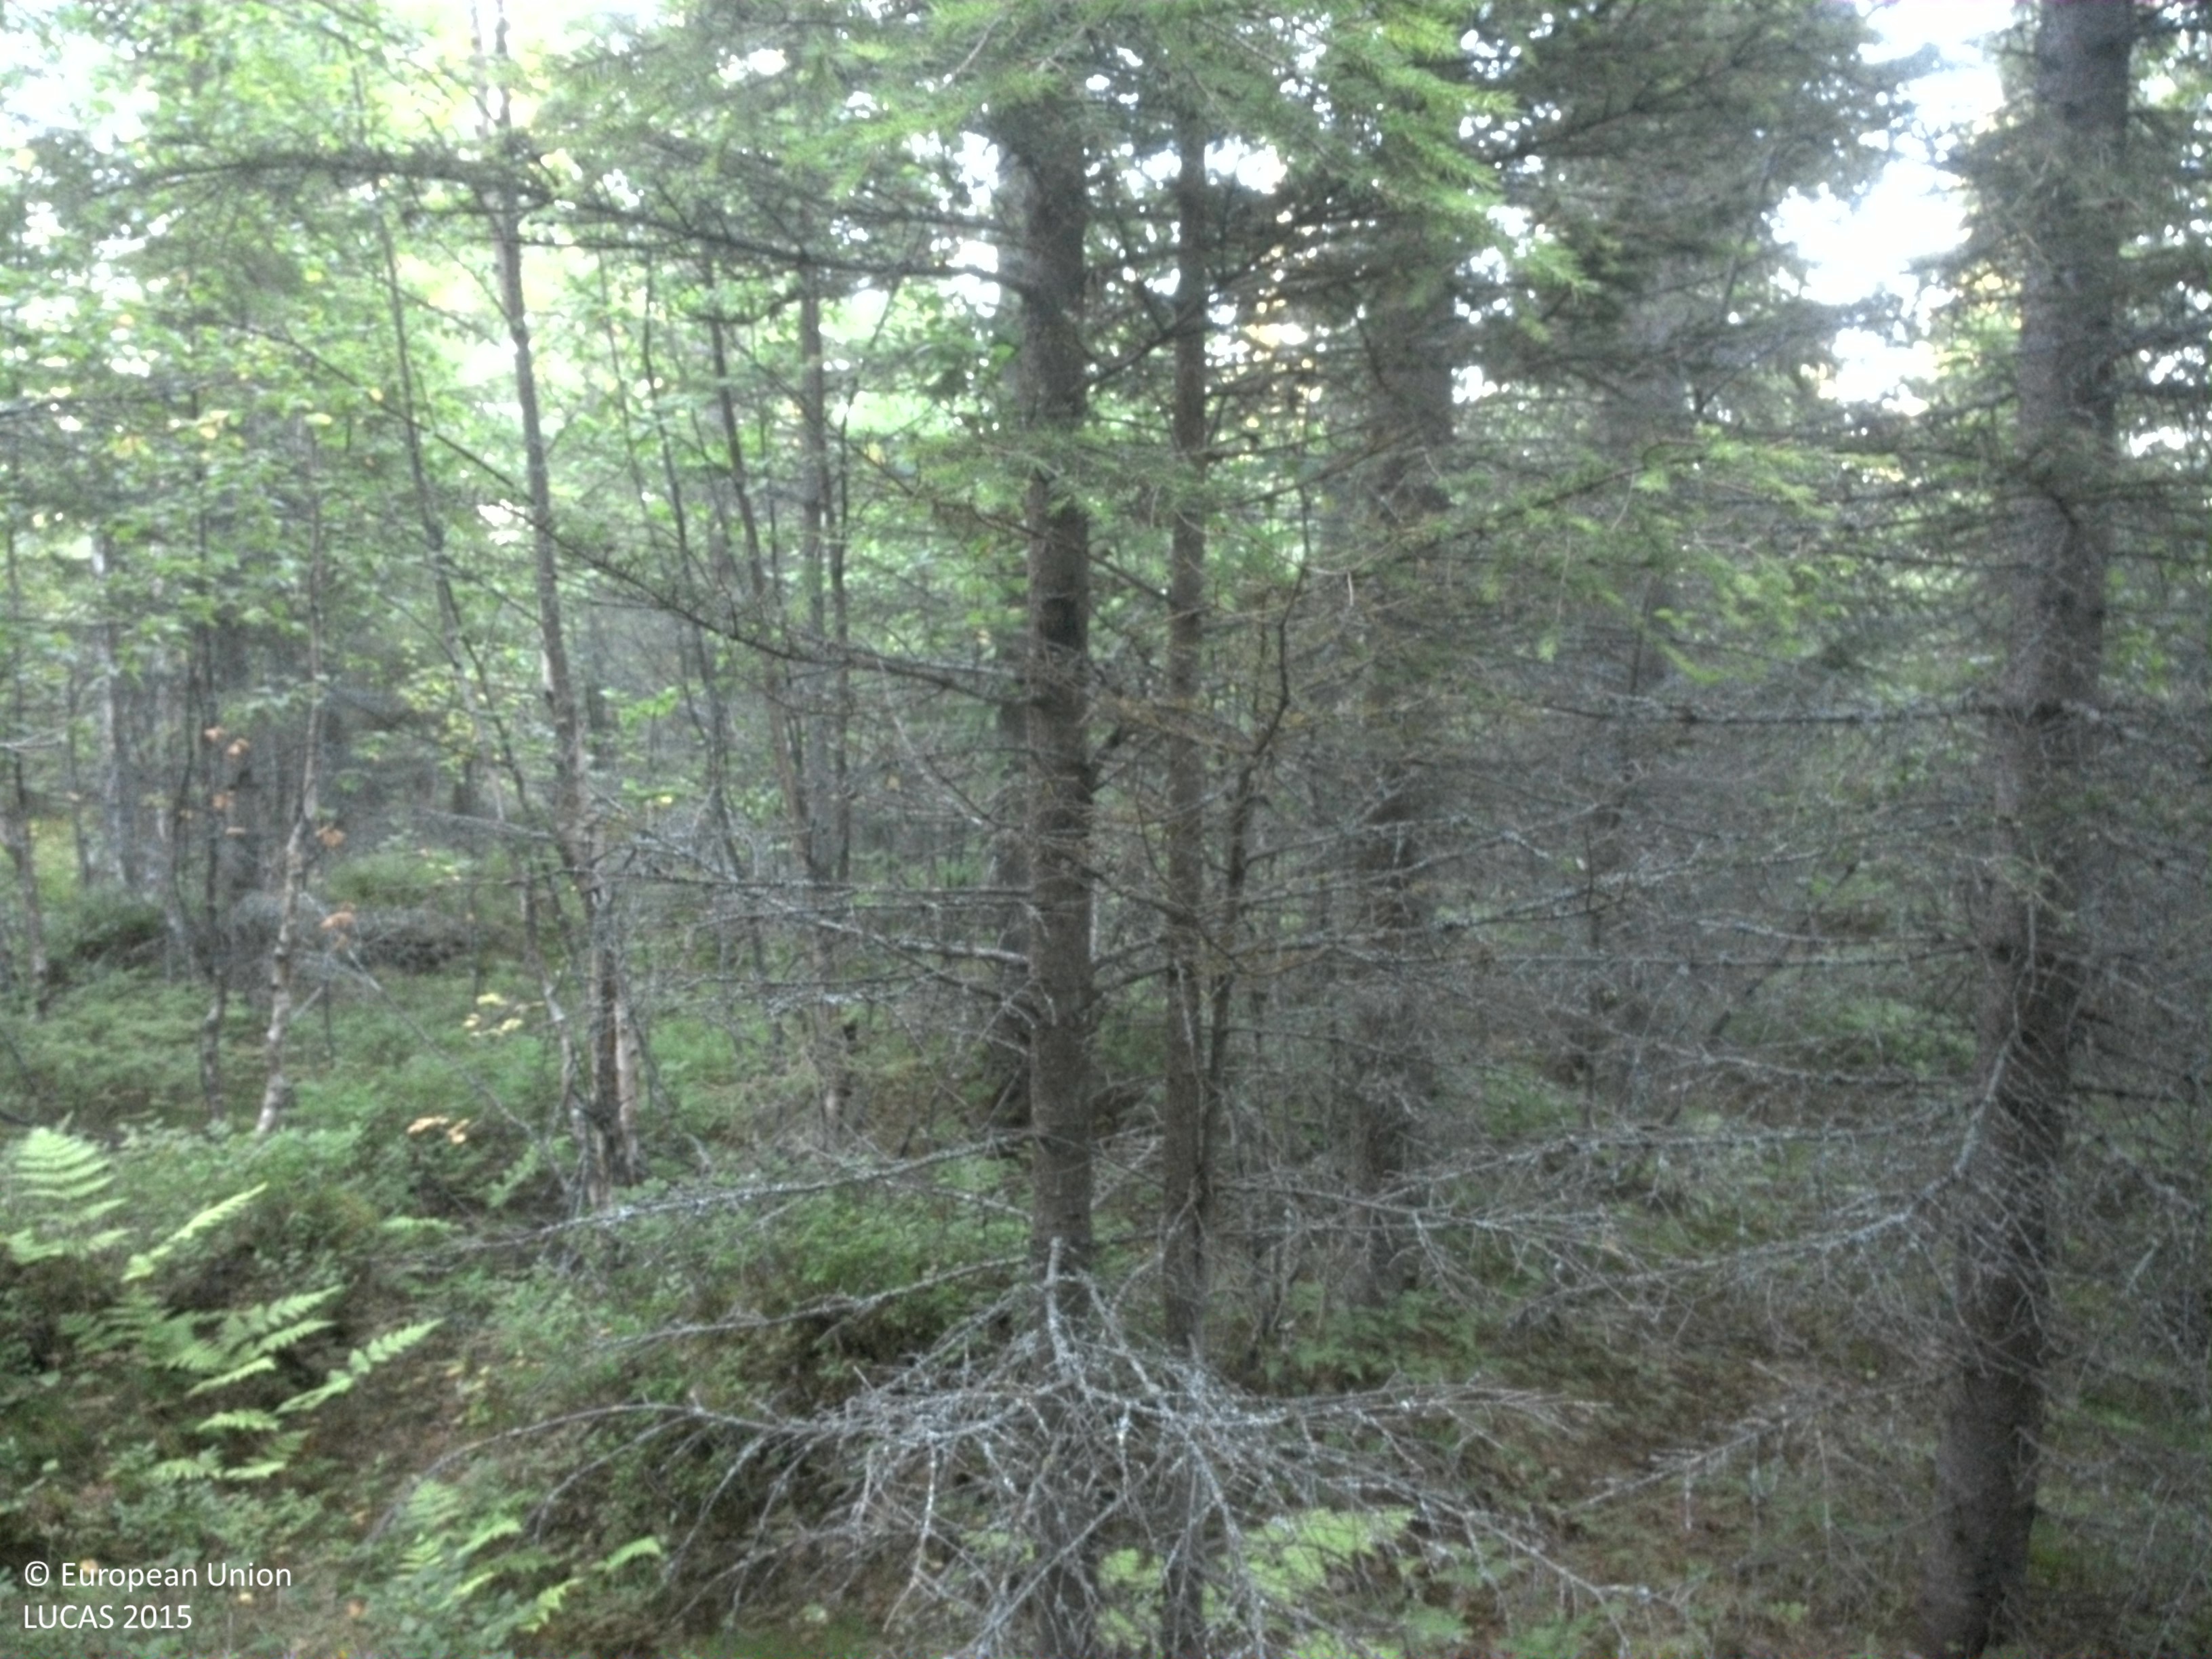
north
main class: Woodland
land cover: Spruce dominated mixed woodland
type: boreal forest
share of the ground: > 75 %
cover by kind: coniferous forest trees 60 %, broadleaved forest trees 20 %, shrubs 10 %, herbaceous plants 10 %
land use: Forestry
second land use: Amenities, museums, leisure
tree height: > 5 m
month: August
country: SE
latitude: 64.3774
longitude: 18.3629
